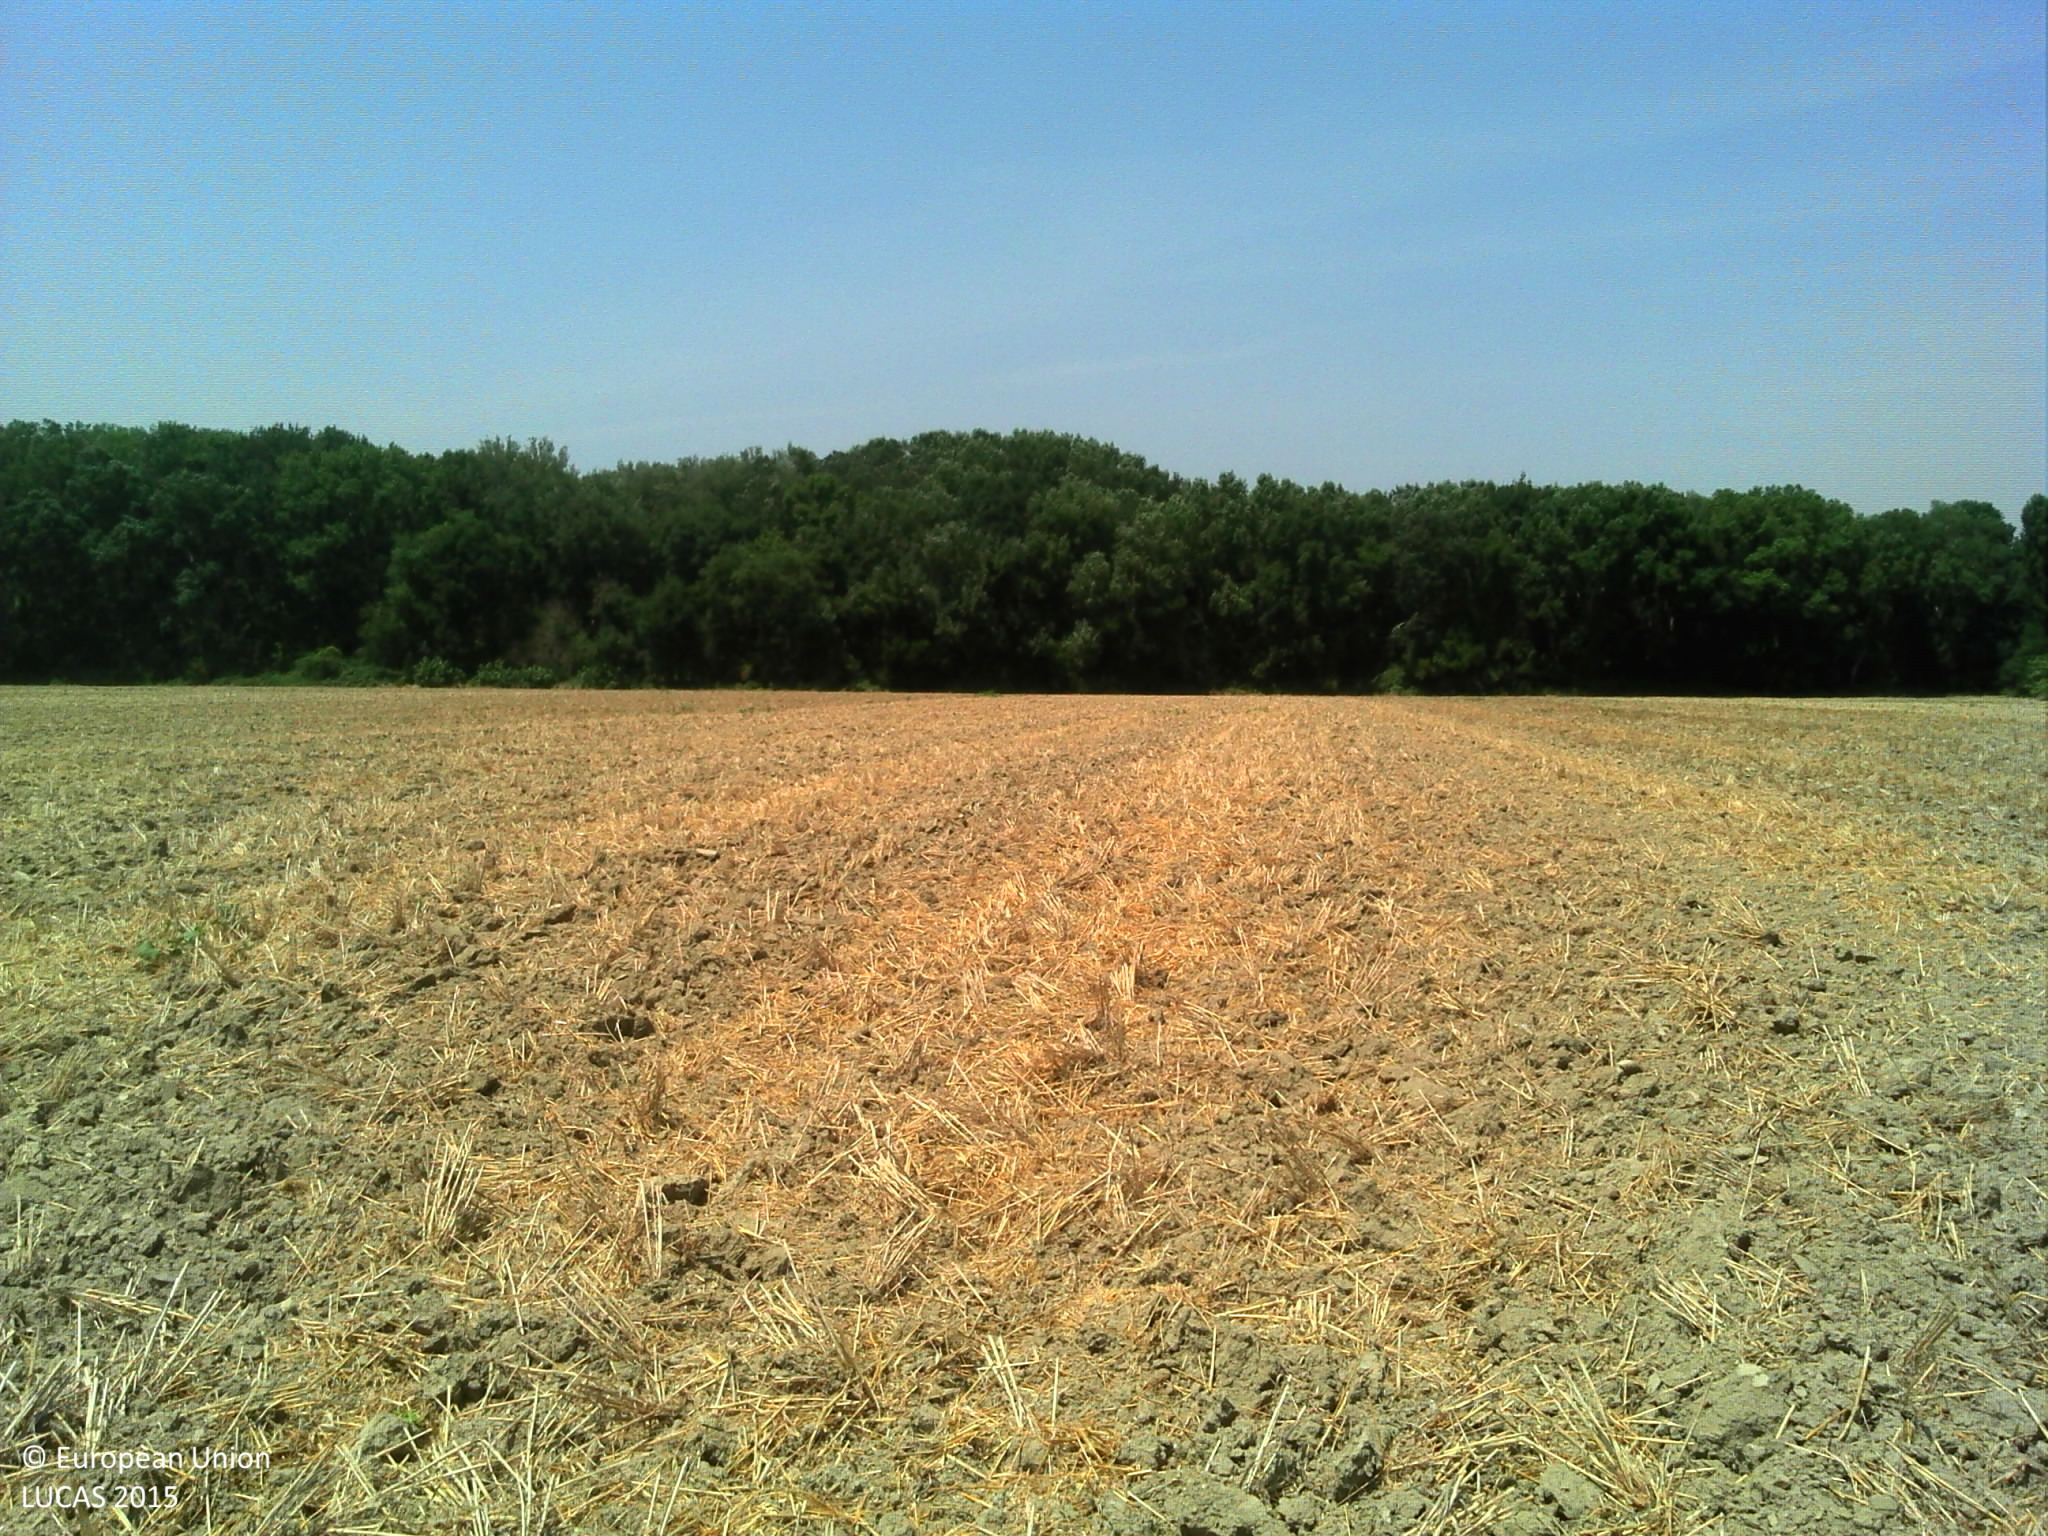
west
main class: Cropland
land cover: Barley
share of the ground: > 75 %
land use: Agriculture (excluding fallow land and kitchen gardens)
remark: Harvested field
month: July
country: FR
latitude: 44.3944
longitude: 4.6715
